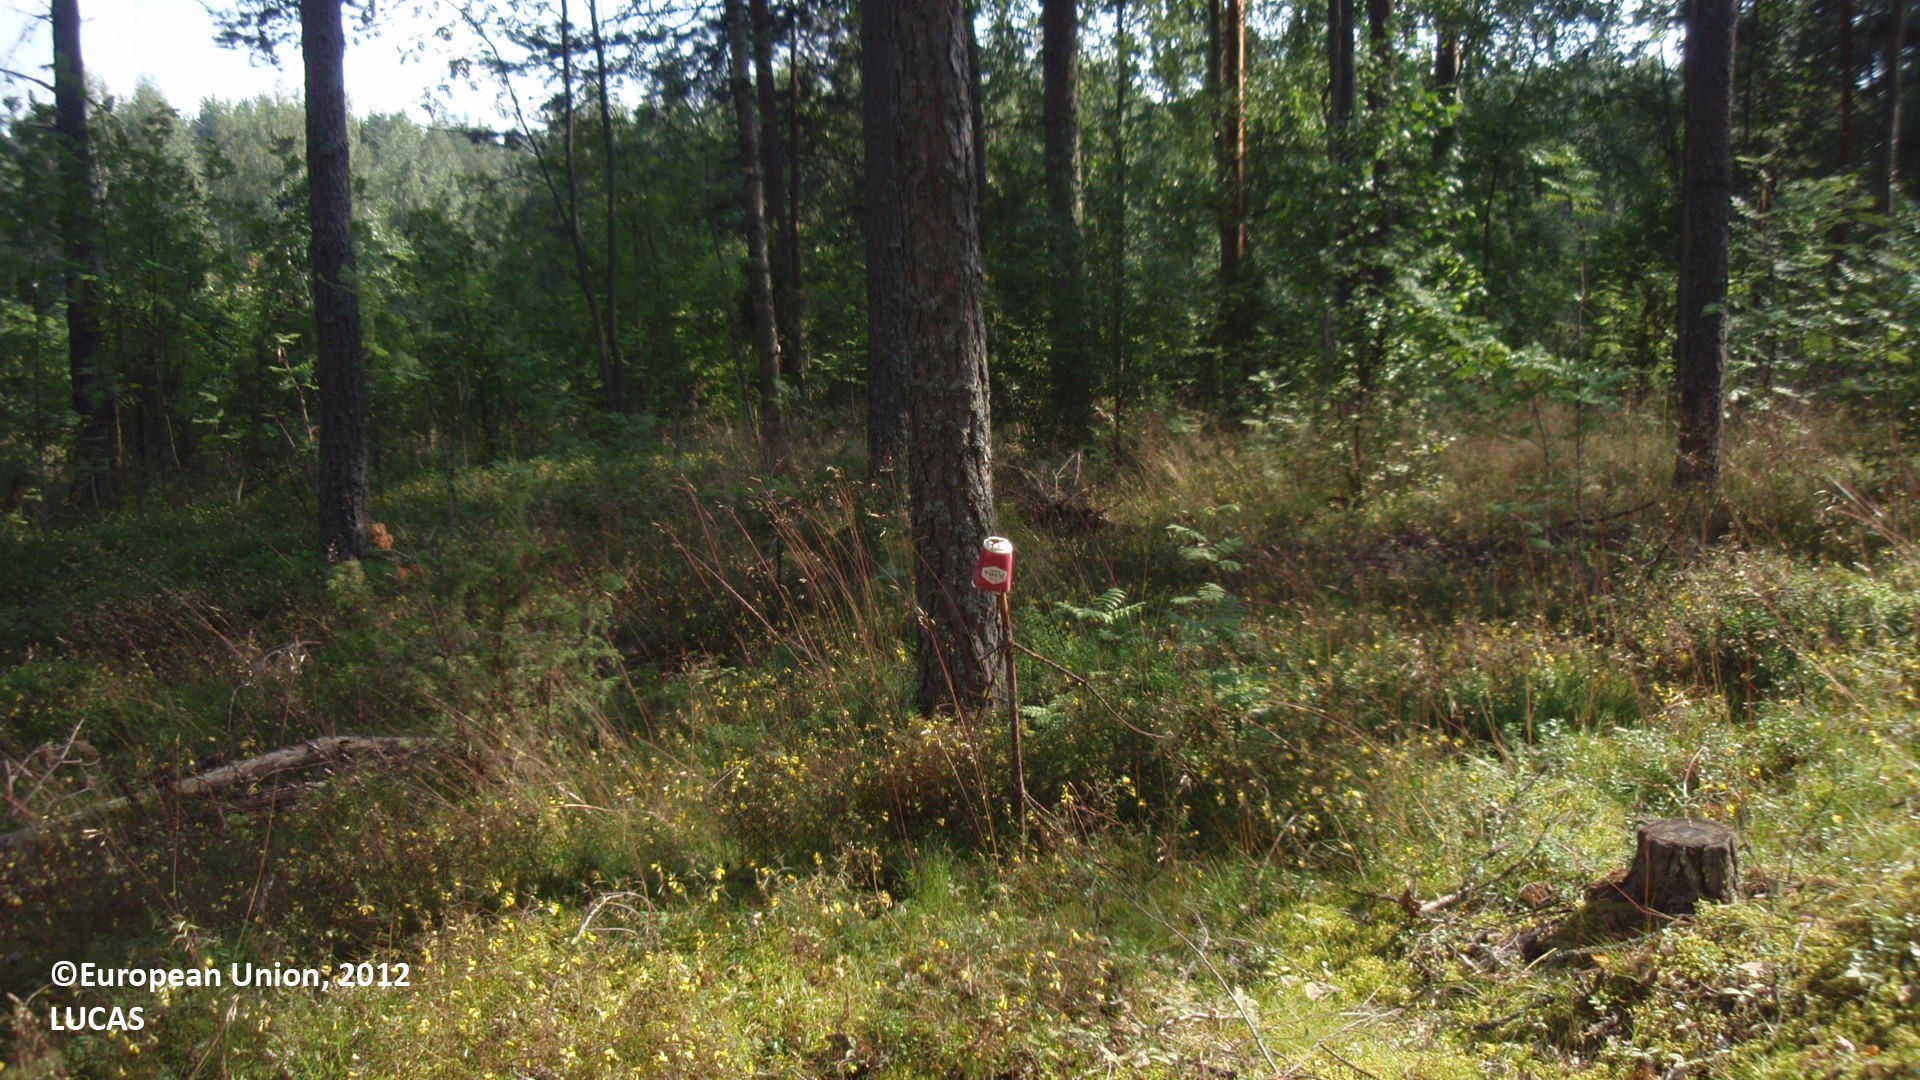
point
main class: Woodland
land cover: Pine dominated coniferous woodland
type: boreal forest
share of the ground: 50 - 75 %
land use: Forestry
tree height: > 5 m
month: July
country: FI
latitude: 61.3982
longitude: 28.3139
